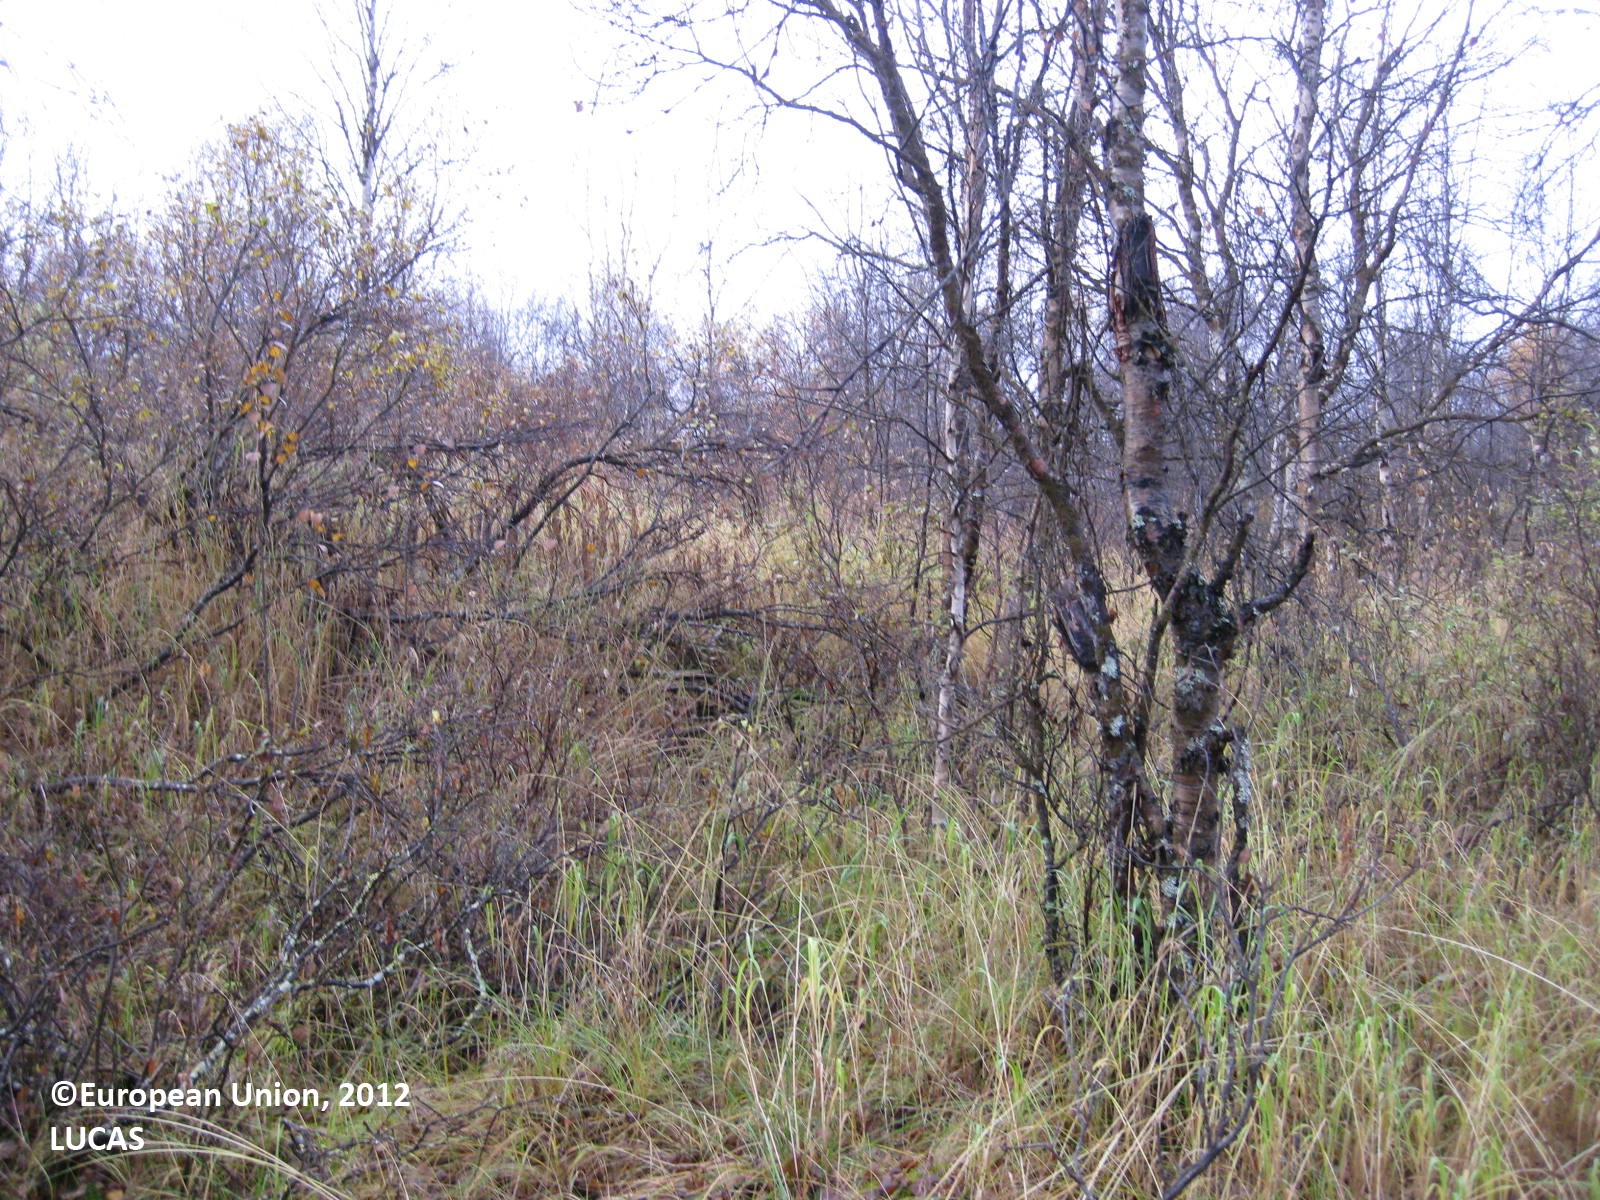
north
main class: Woodland
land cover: Broadleaved woodland
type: boreal forest
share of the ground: 50 - 75 %
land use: Forestry
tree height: > 5 m
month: September
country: FI
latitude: 68.4080
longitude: 23.9620
